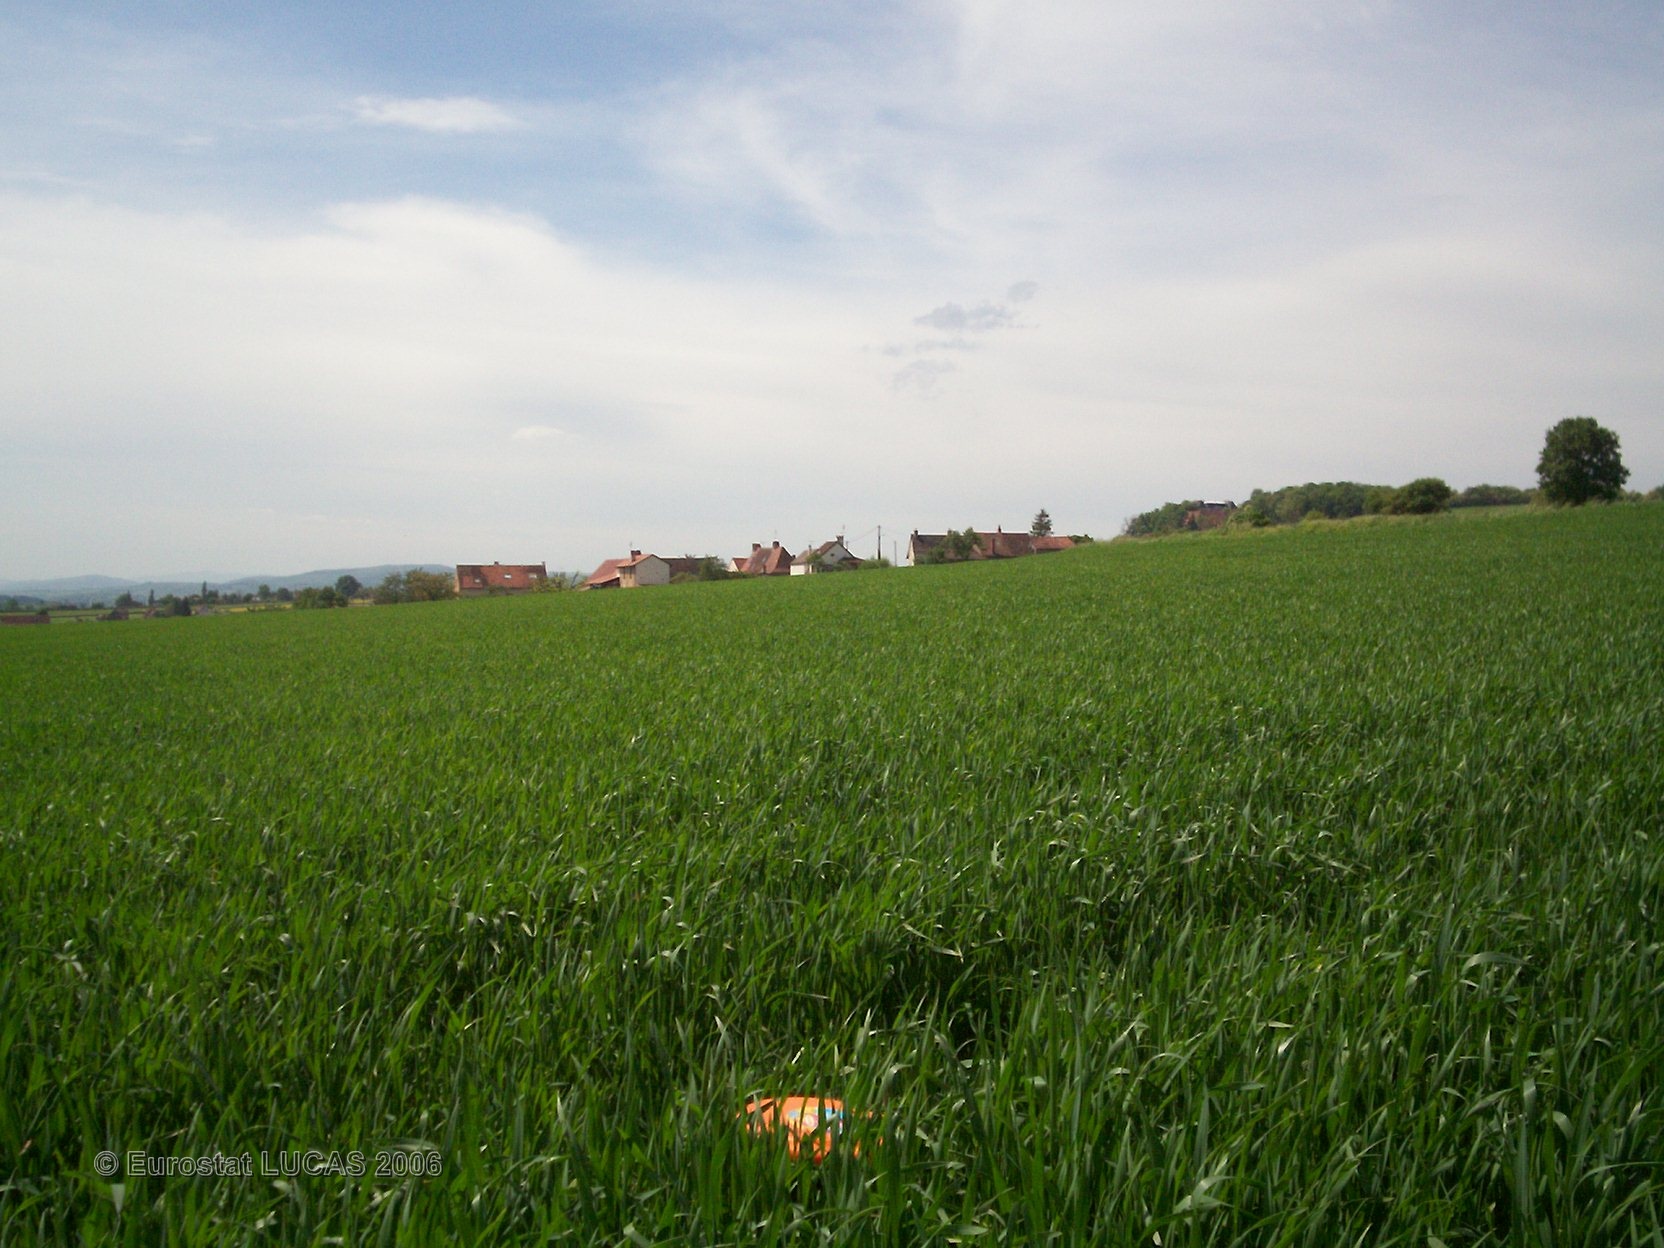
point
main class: Cropland
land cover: Common wheat
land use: Agriculture (excluding fallow land and kitchen gardens)
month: May
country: FR
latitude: 46.5636
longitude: 4.7181
